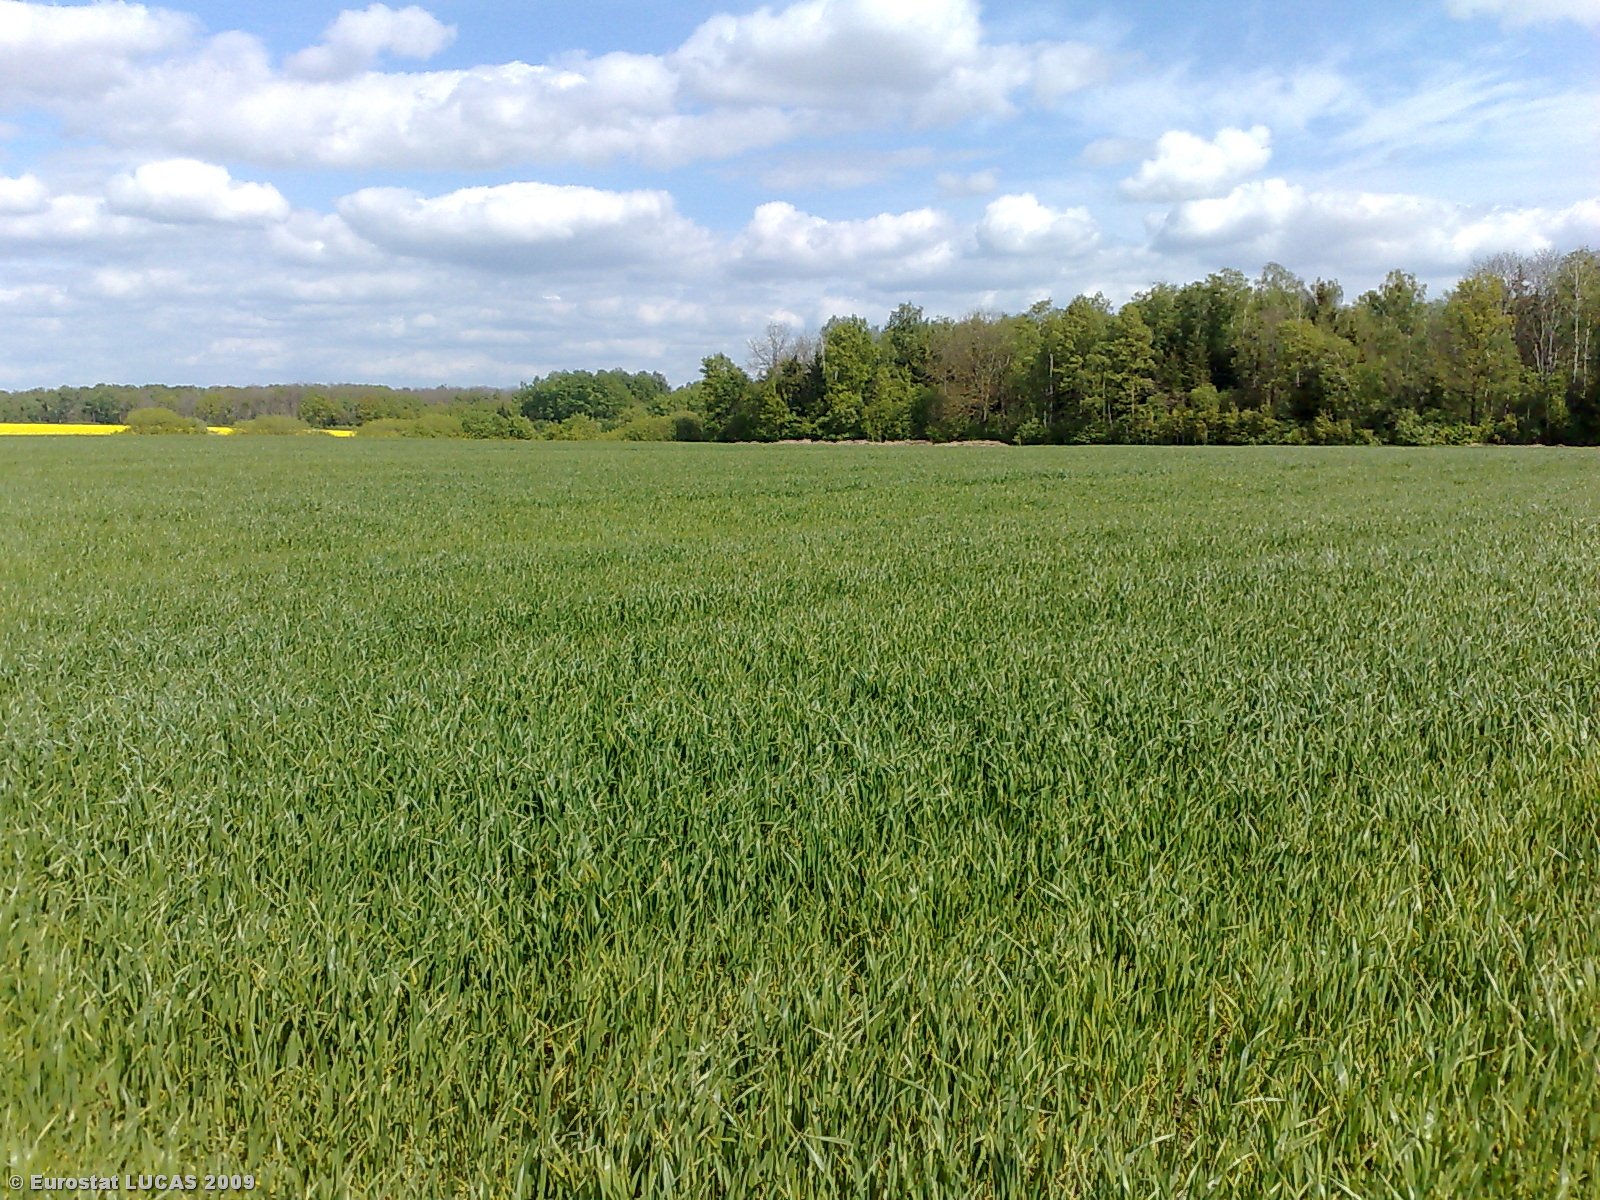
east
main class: Cropland
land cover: Common wheat
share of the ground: > 75 %
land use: Agriculture (excluding fallow land and kitchen gardens)
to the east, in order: Common wheat; Grassland without tree/shrub cover; Broadleaved woodland
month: May
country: LT
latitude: 55.7829
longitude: 23.8132
